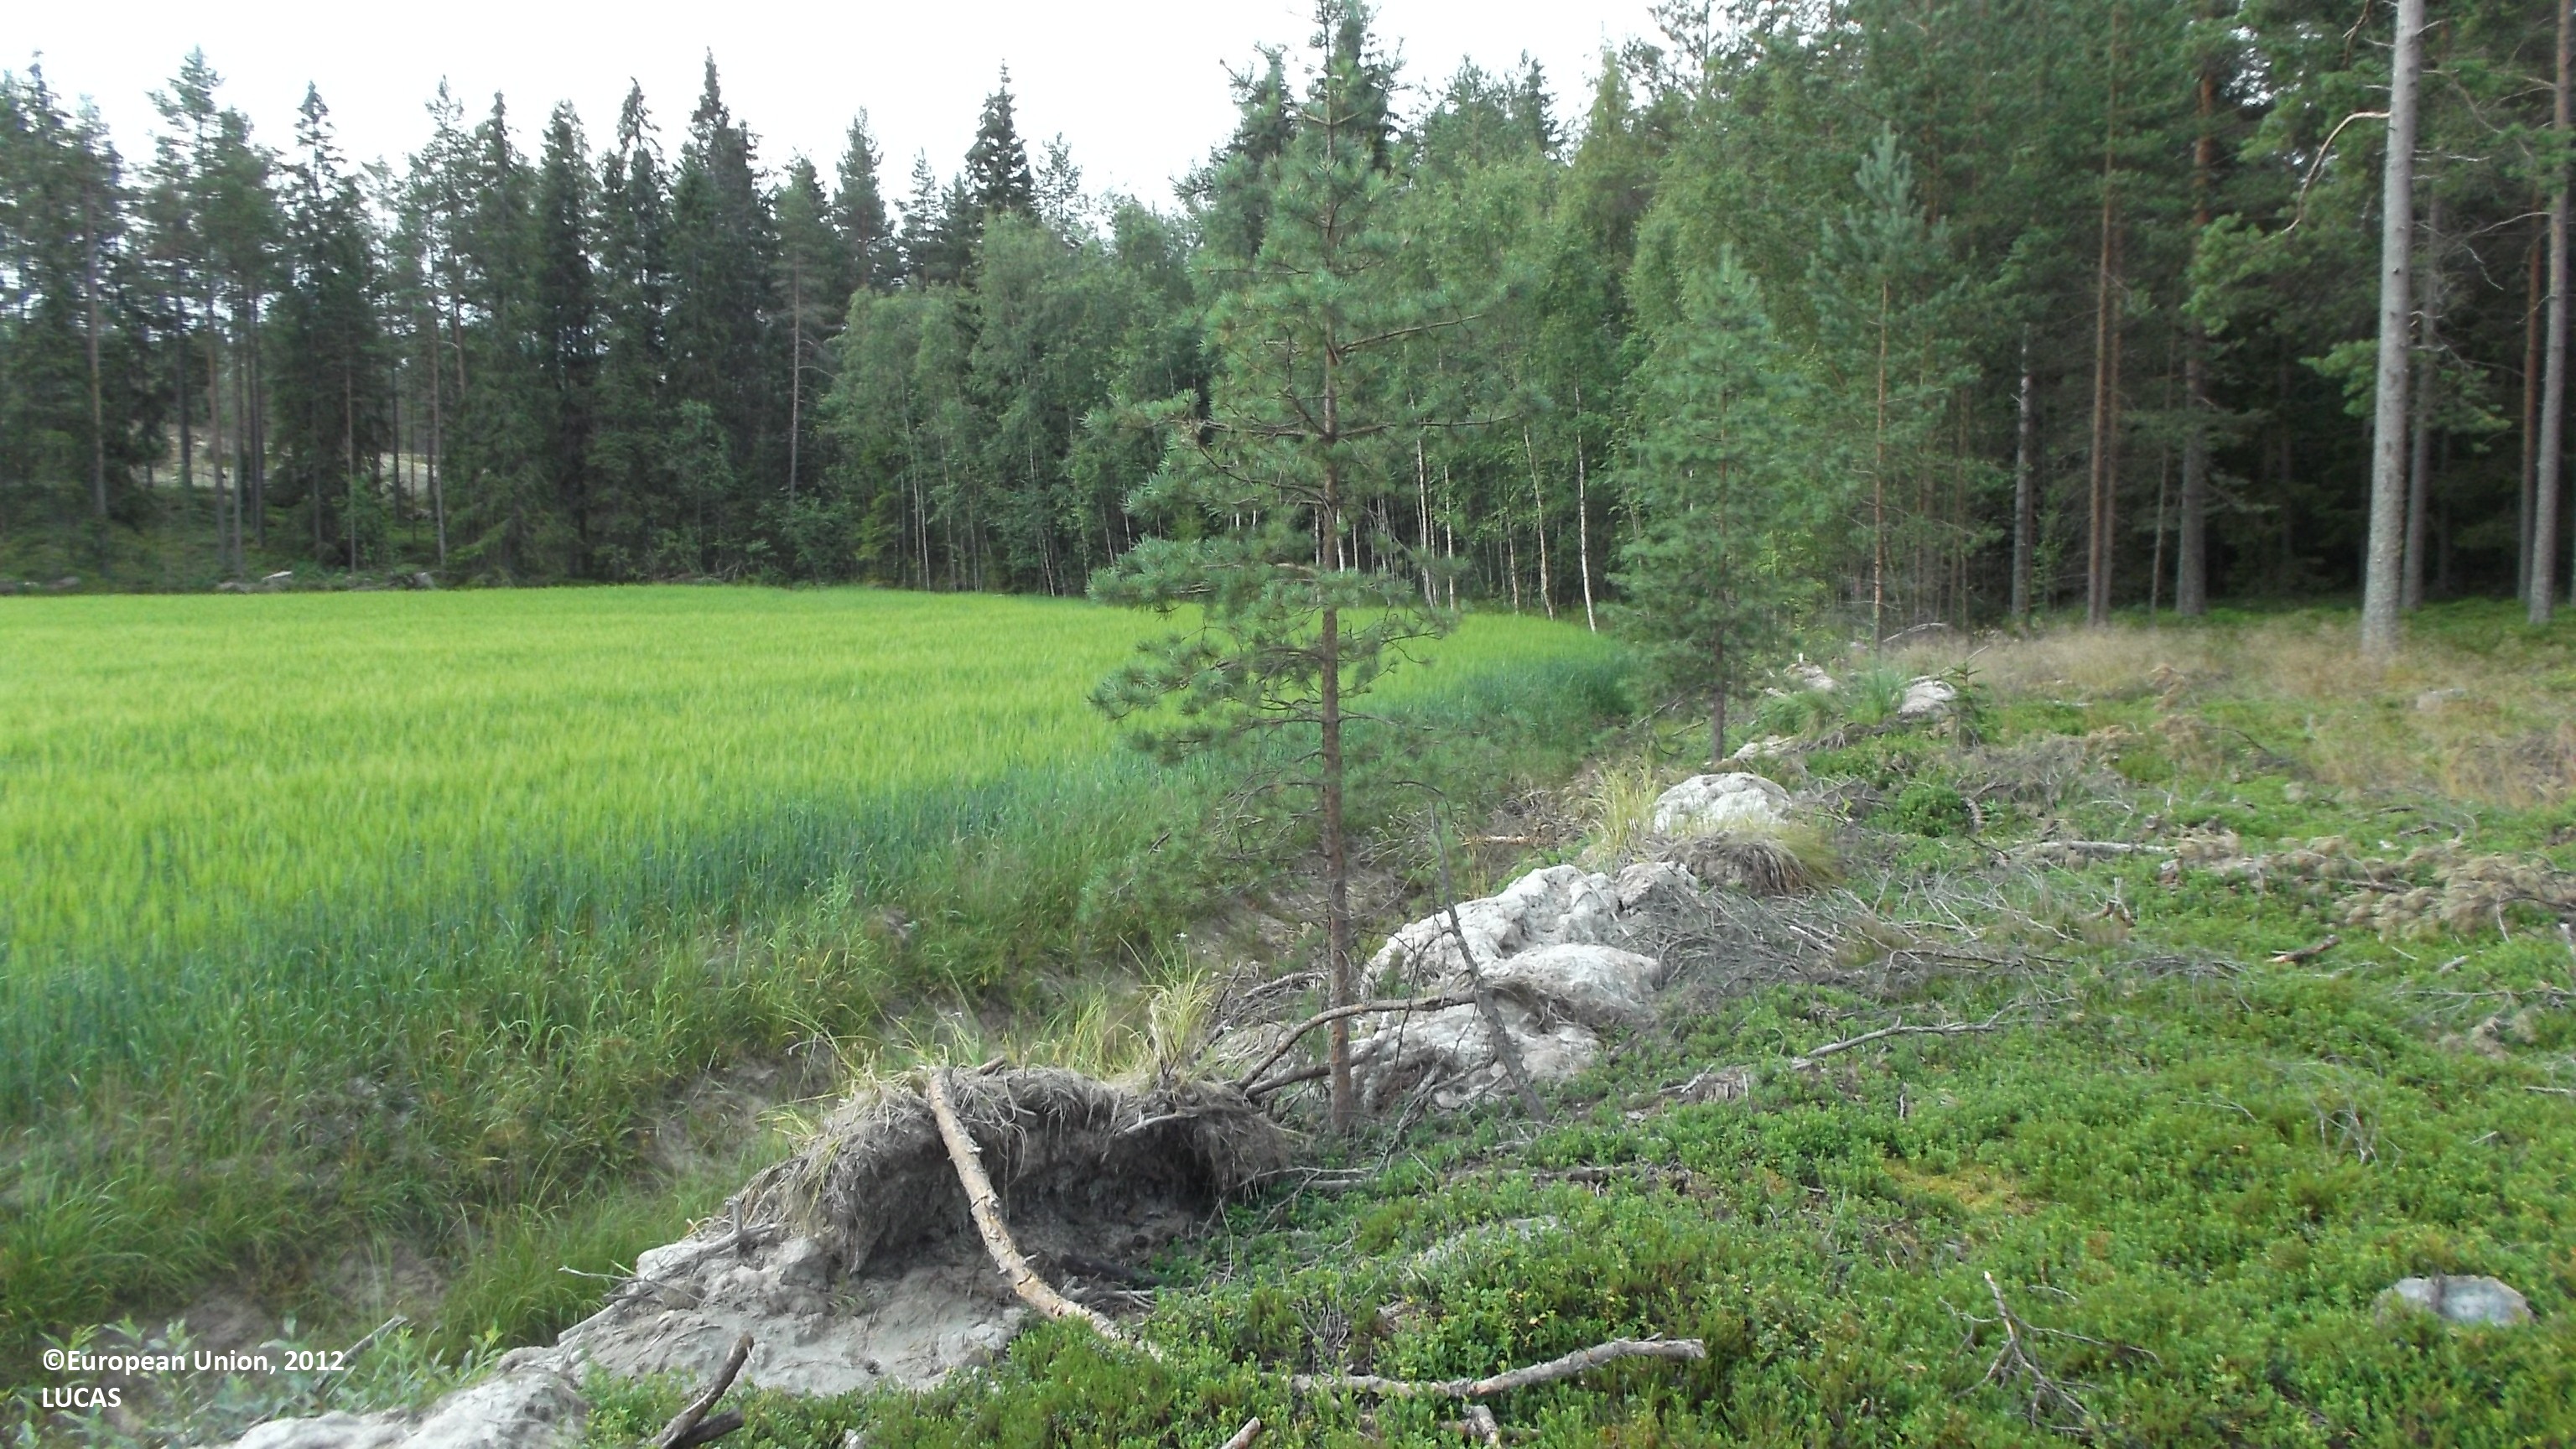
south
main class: Woodland
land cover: Pine dominated coniferous woodland
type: boreal forest
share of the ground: 10 - 25 %
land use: Forestry
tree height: > 5 m
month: July
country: FI
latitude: 63.9707
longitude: 23.4343
